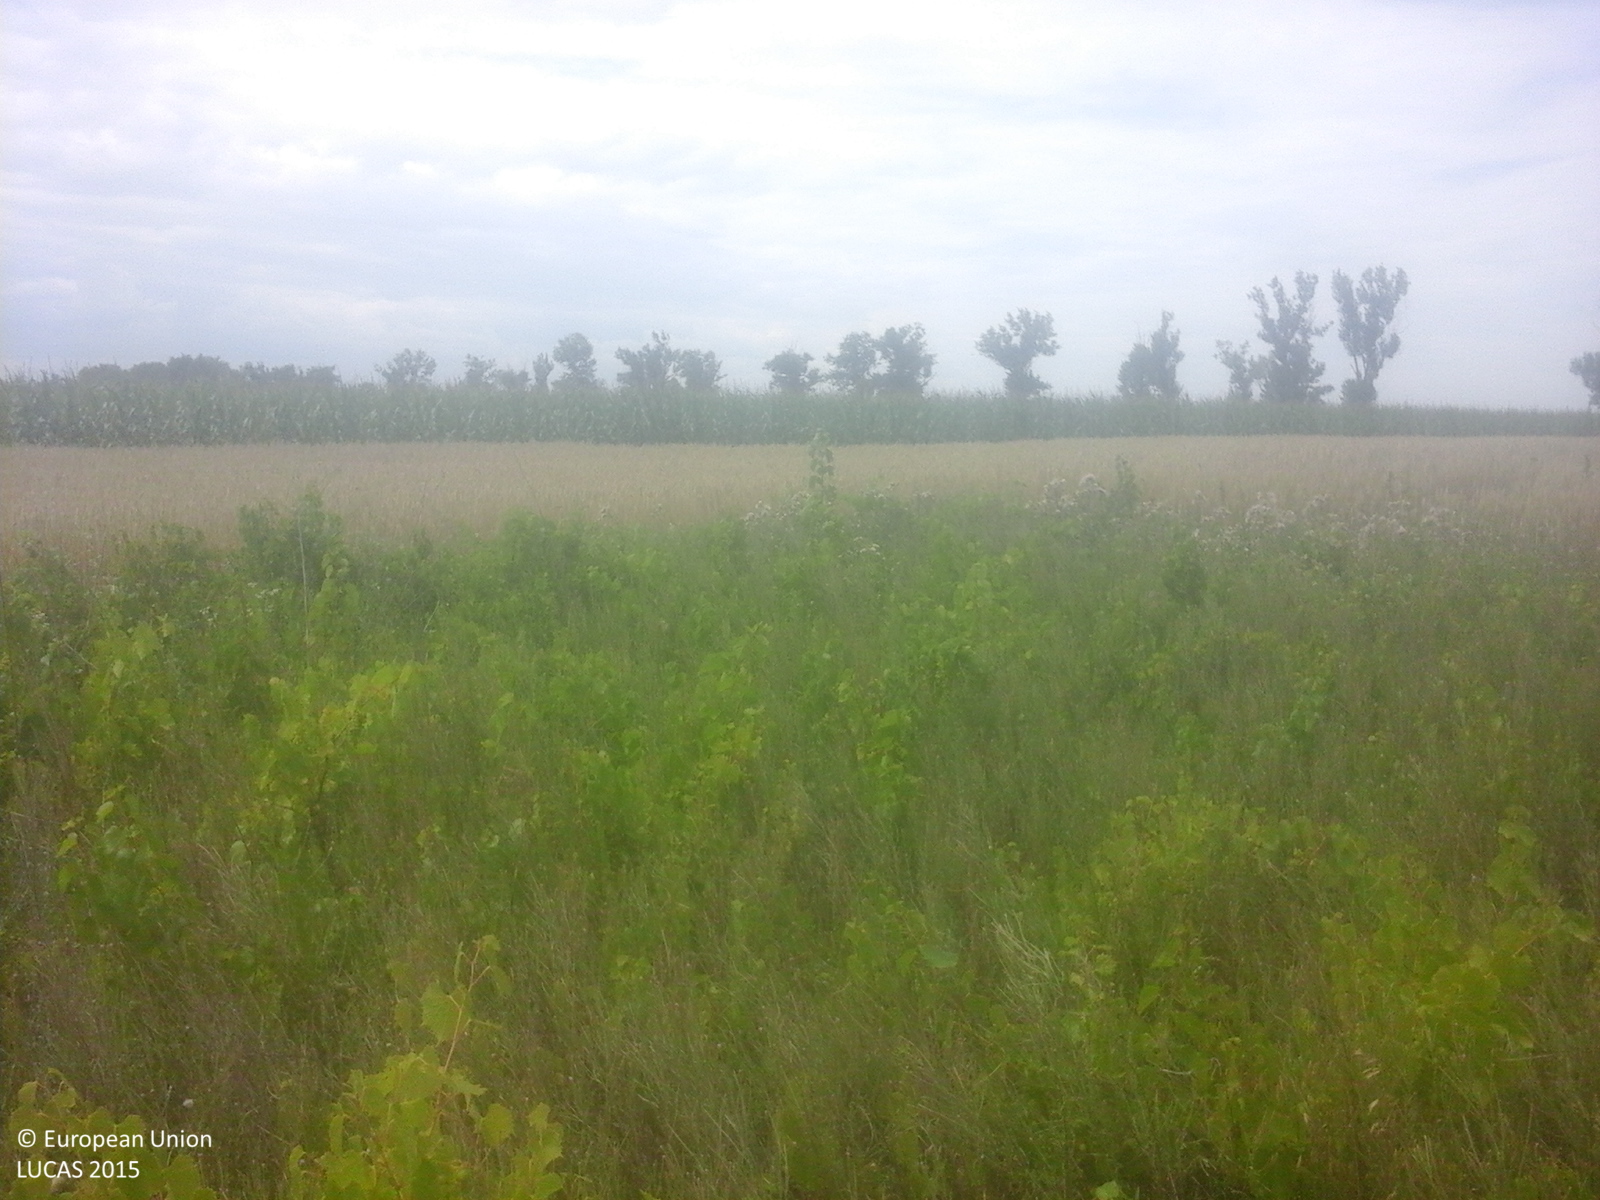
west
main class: Cropland
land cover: Vineyards
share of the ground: 50 - 75 %
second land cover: Spontaneously vegetated surfaces
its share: 50 - 75 %
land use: Abandoned areas
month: July
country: RO
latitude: 44.1451
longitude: 25.5281
